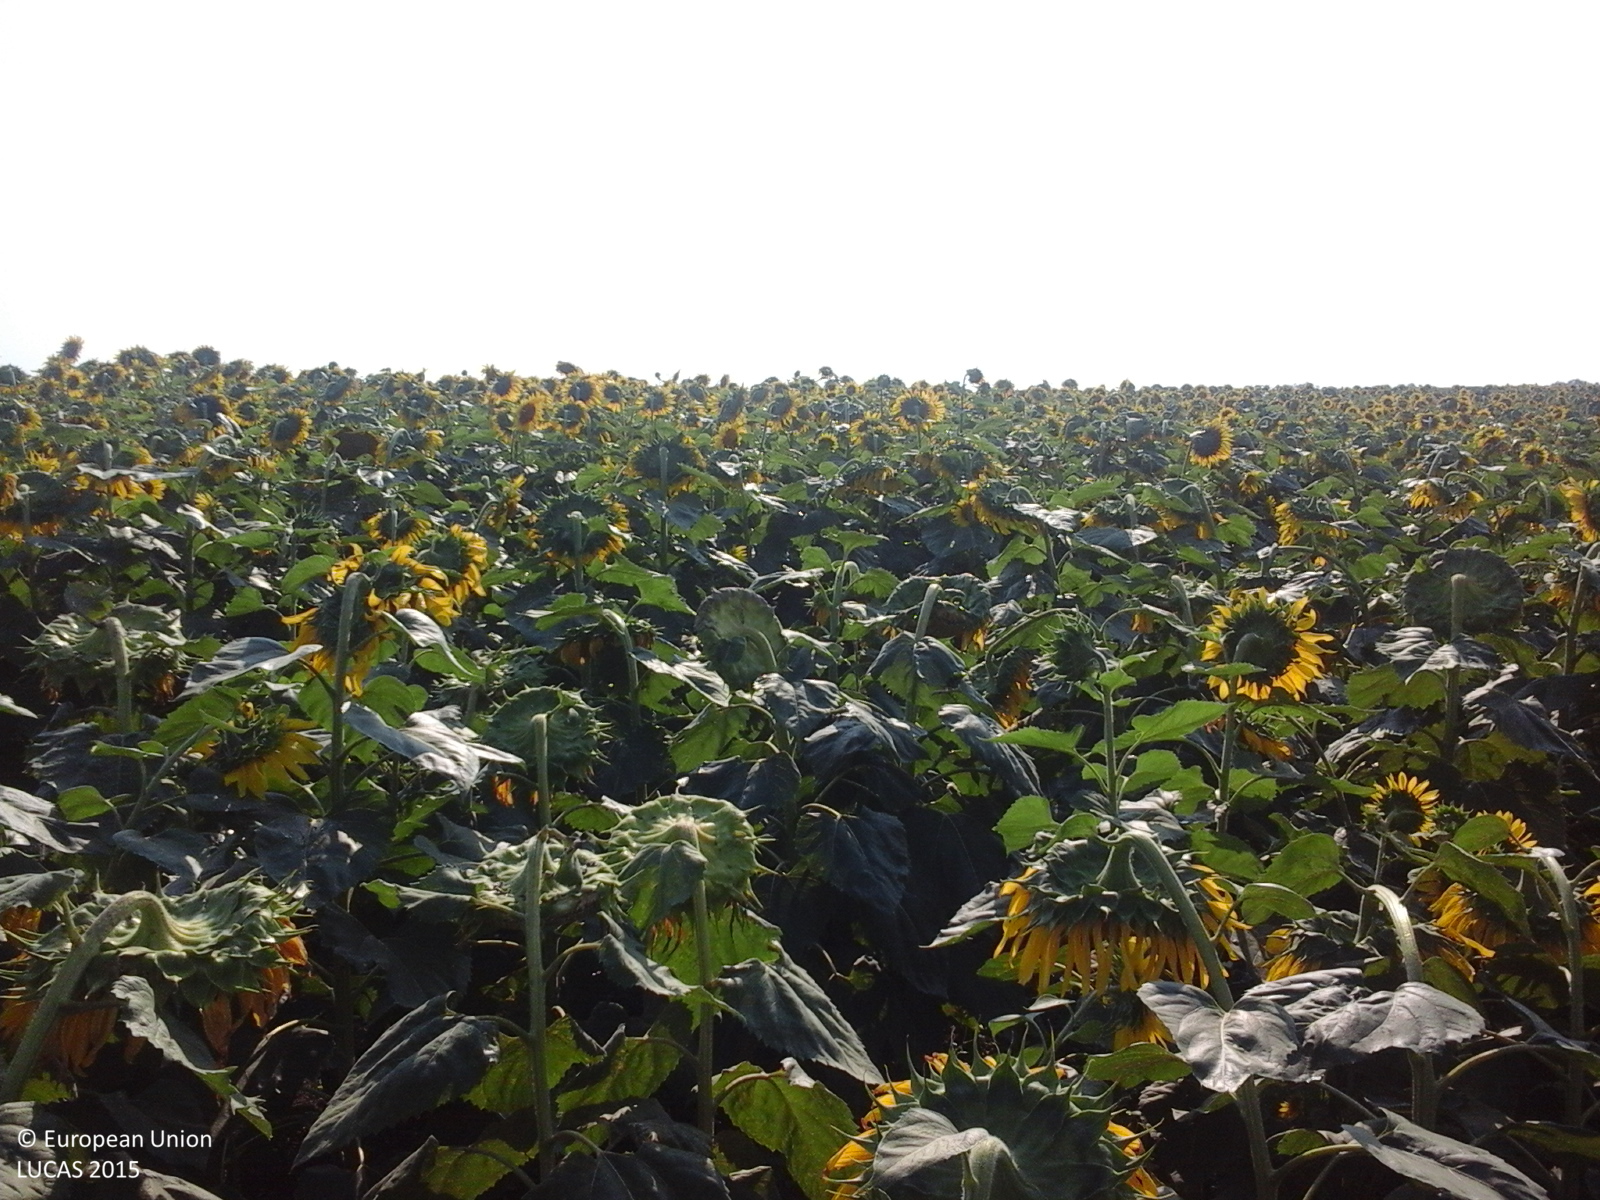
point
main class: Cropland
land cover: Sunflower
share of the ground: > 75 %
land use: Agriculture (excluding fallow land and kitchen gardens)
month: August
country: RO
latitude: 46.4768
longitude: 21.6445
